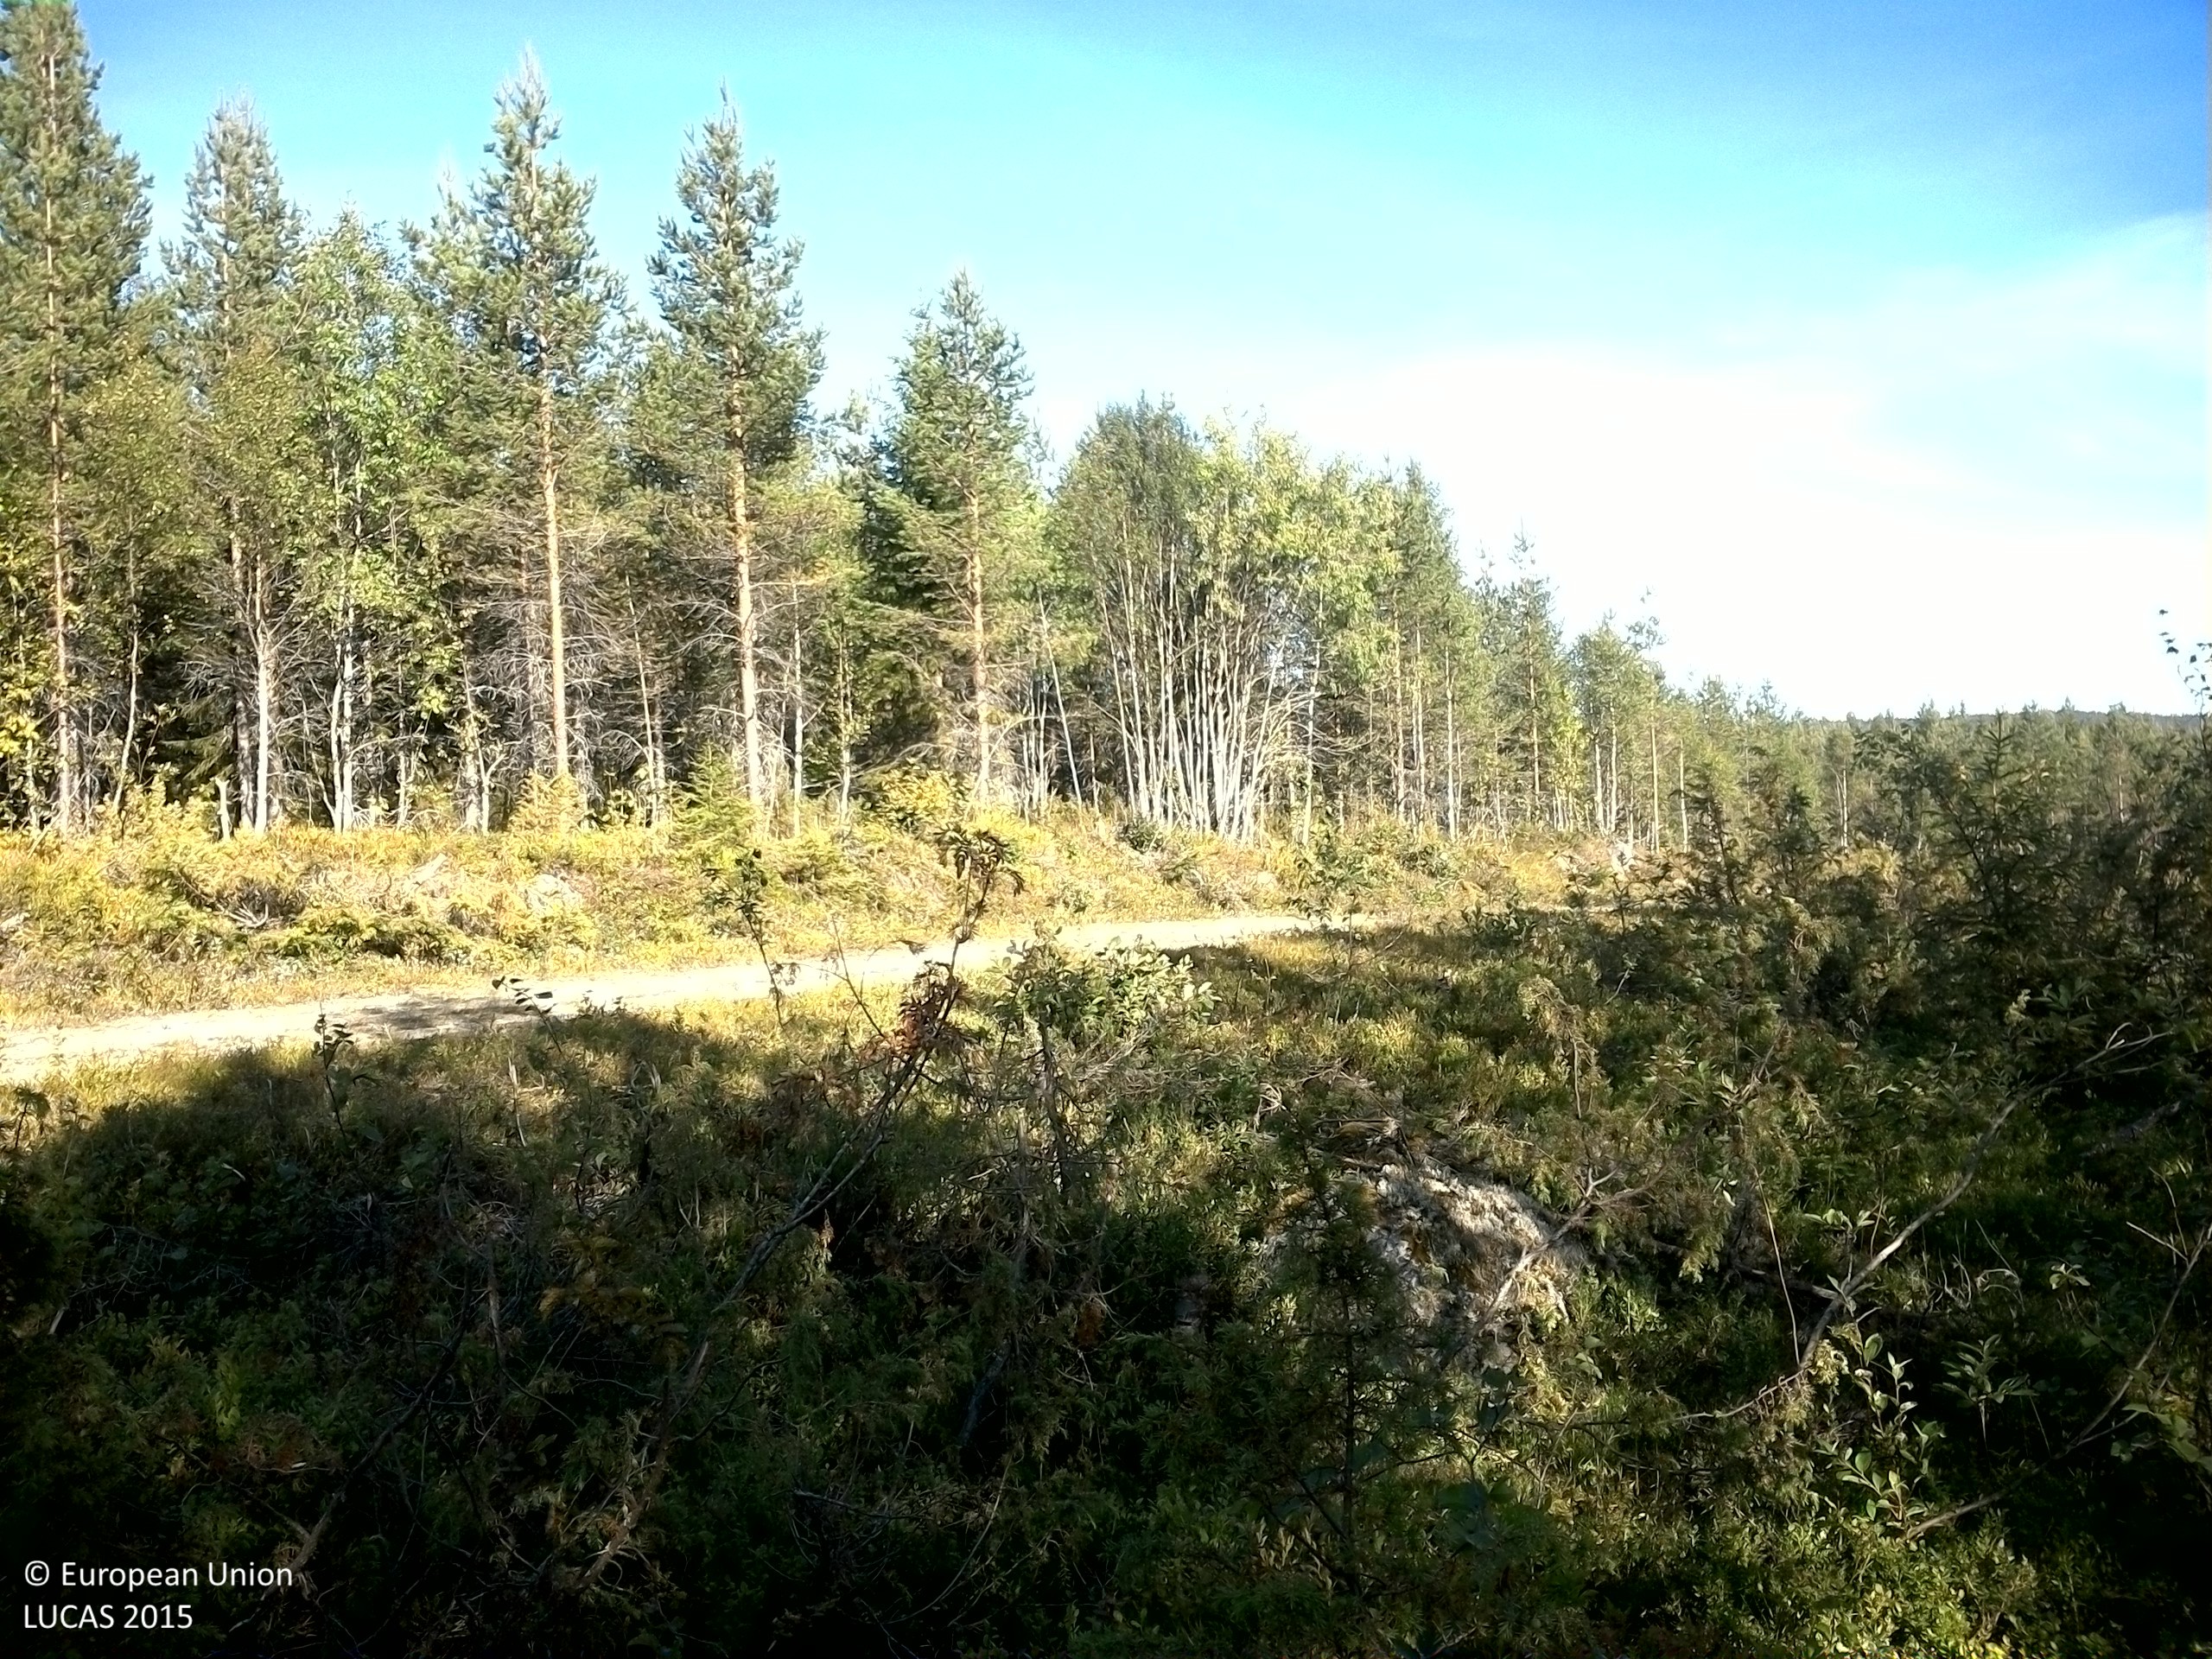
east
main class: Woodland
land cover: Other mixed woodland
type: boreal forest
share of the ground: > 75 %
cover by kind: coniferous forest trees 40 %, broadleaved forest trees 35 %, shrubs 25 %
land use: Forestry
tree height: < 5 m
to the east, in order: Other mixed woodland; Paved roads, cycling and walking lanes; Ditches and canals; Shrubland with sparse tree cover; Pine dominated coniferous woodland; Pine dominated mixed woodland; Ditches and canals; Paved roads, cycling and walking lanes; Ditches and canals; Spruce dominated mixed woodland
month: August
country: SE
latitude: 63.8172
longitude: 17.5895
